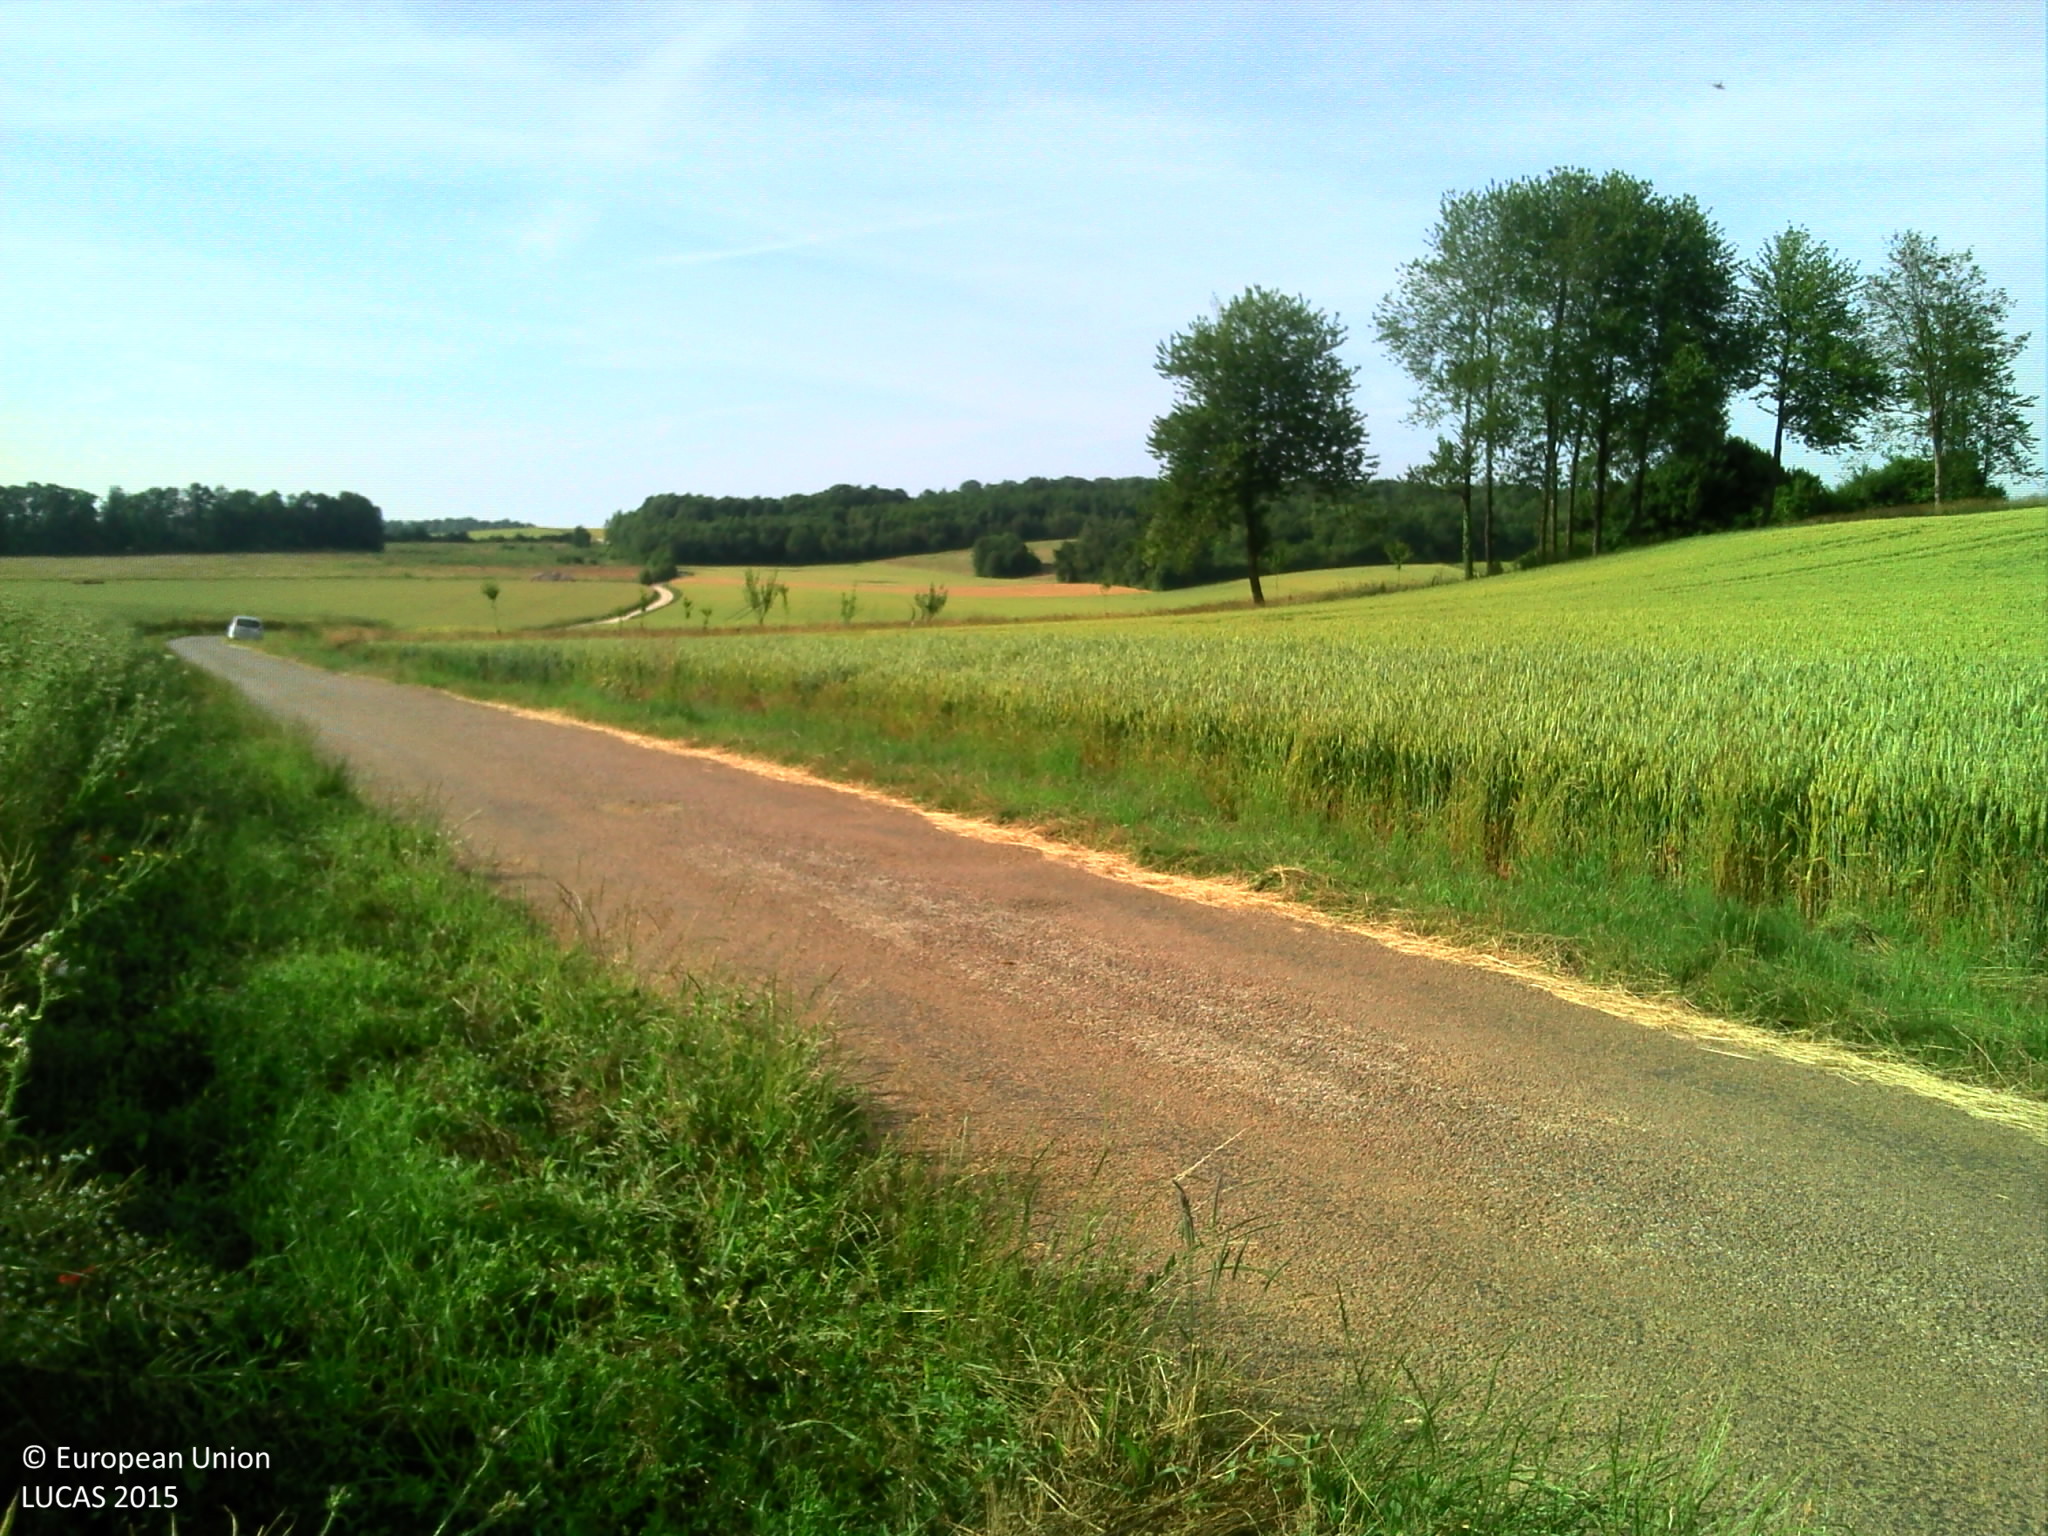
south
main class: Cropland
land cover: Rape and turnip rape
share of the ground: 50 - 75 %
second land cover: Spontaneously vegetated surfaces
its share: 25 - 50 %
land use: Agriculture (excluding fallow land and kitchen gardens)
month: June
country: FR
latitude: 48.5680
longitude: 5.1606
